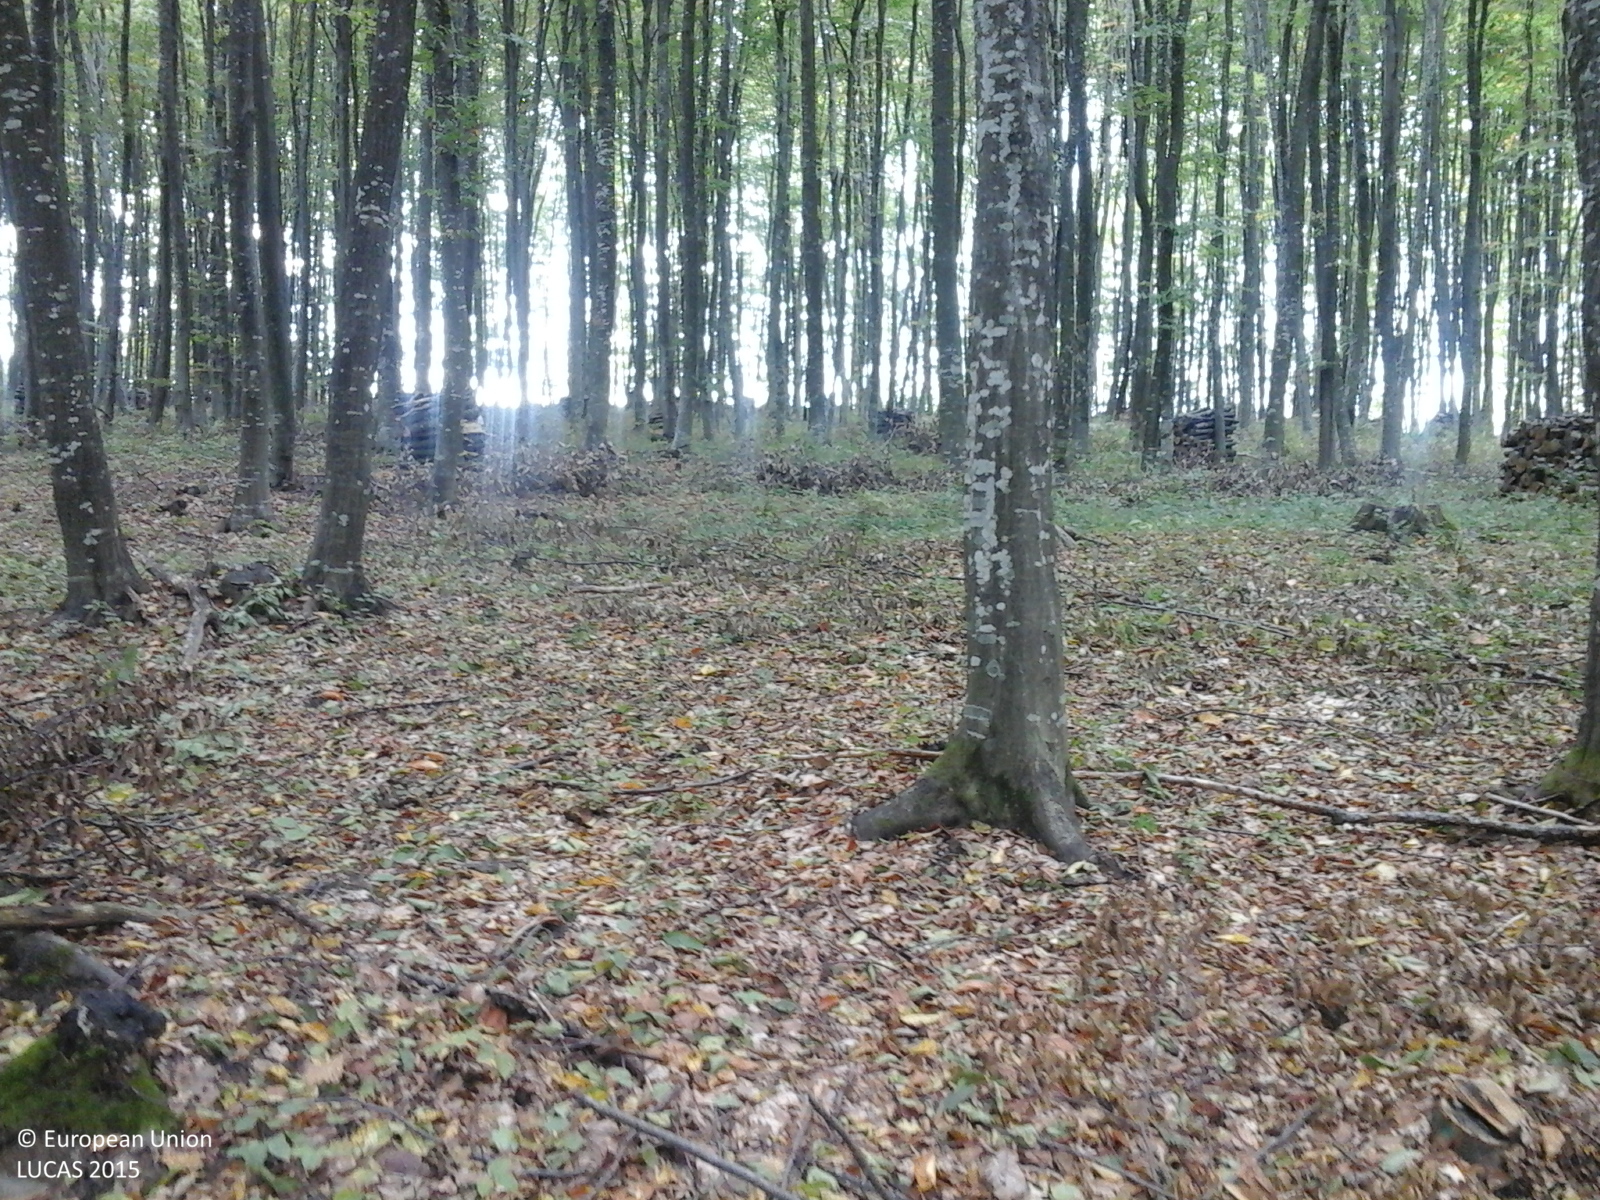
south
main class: Woodland
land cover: Broadleaved woodland
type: beech forest
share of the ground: > 75 %
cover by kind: broadleaved forest trees 100 %
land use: Forestry
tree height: > 5 m
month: October
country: RO
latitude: 46.4599
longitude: 25.1125
